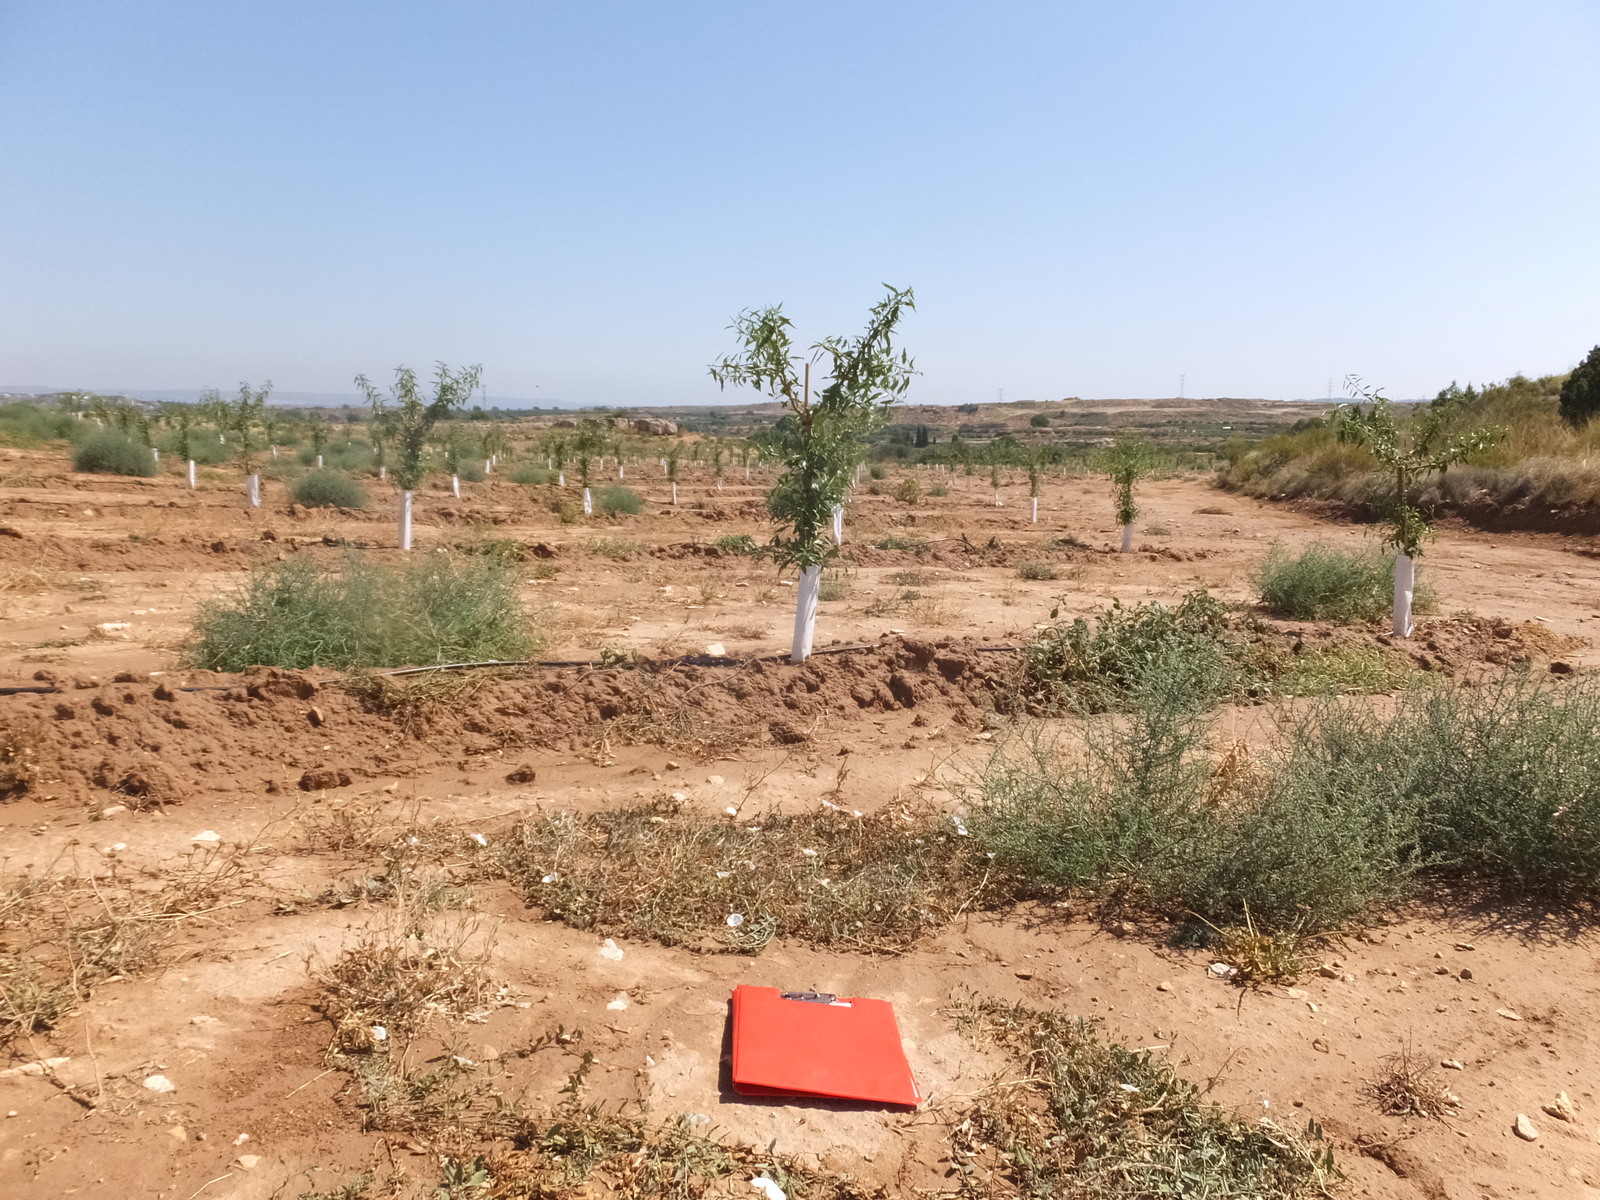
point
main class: Cropland
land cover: Nuts trees
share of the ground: 10 - 25 %
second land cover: Spontaneously vegetated surfaces
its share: < 10 %
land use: Agriculture (excluding fallow land and kitchen gardens)
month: July
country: ES
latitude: 41.1898
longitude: -0.0391
